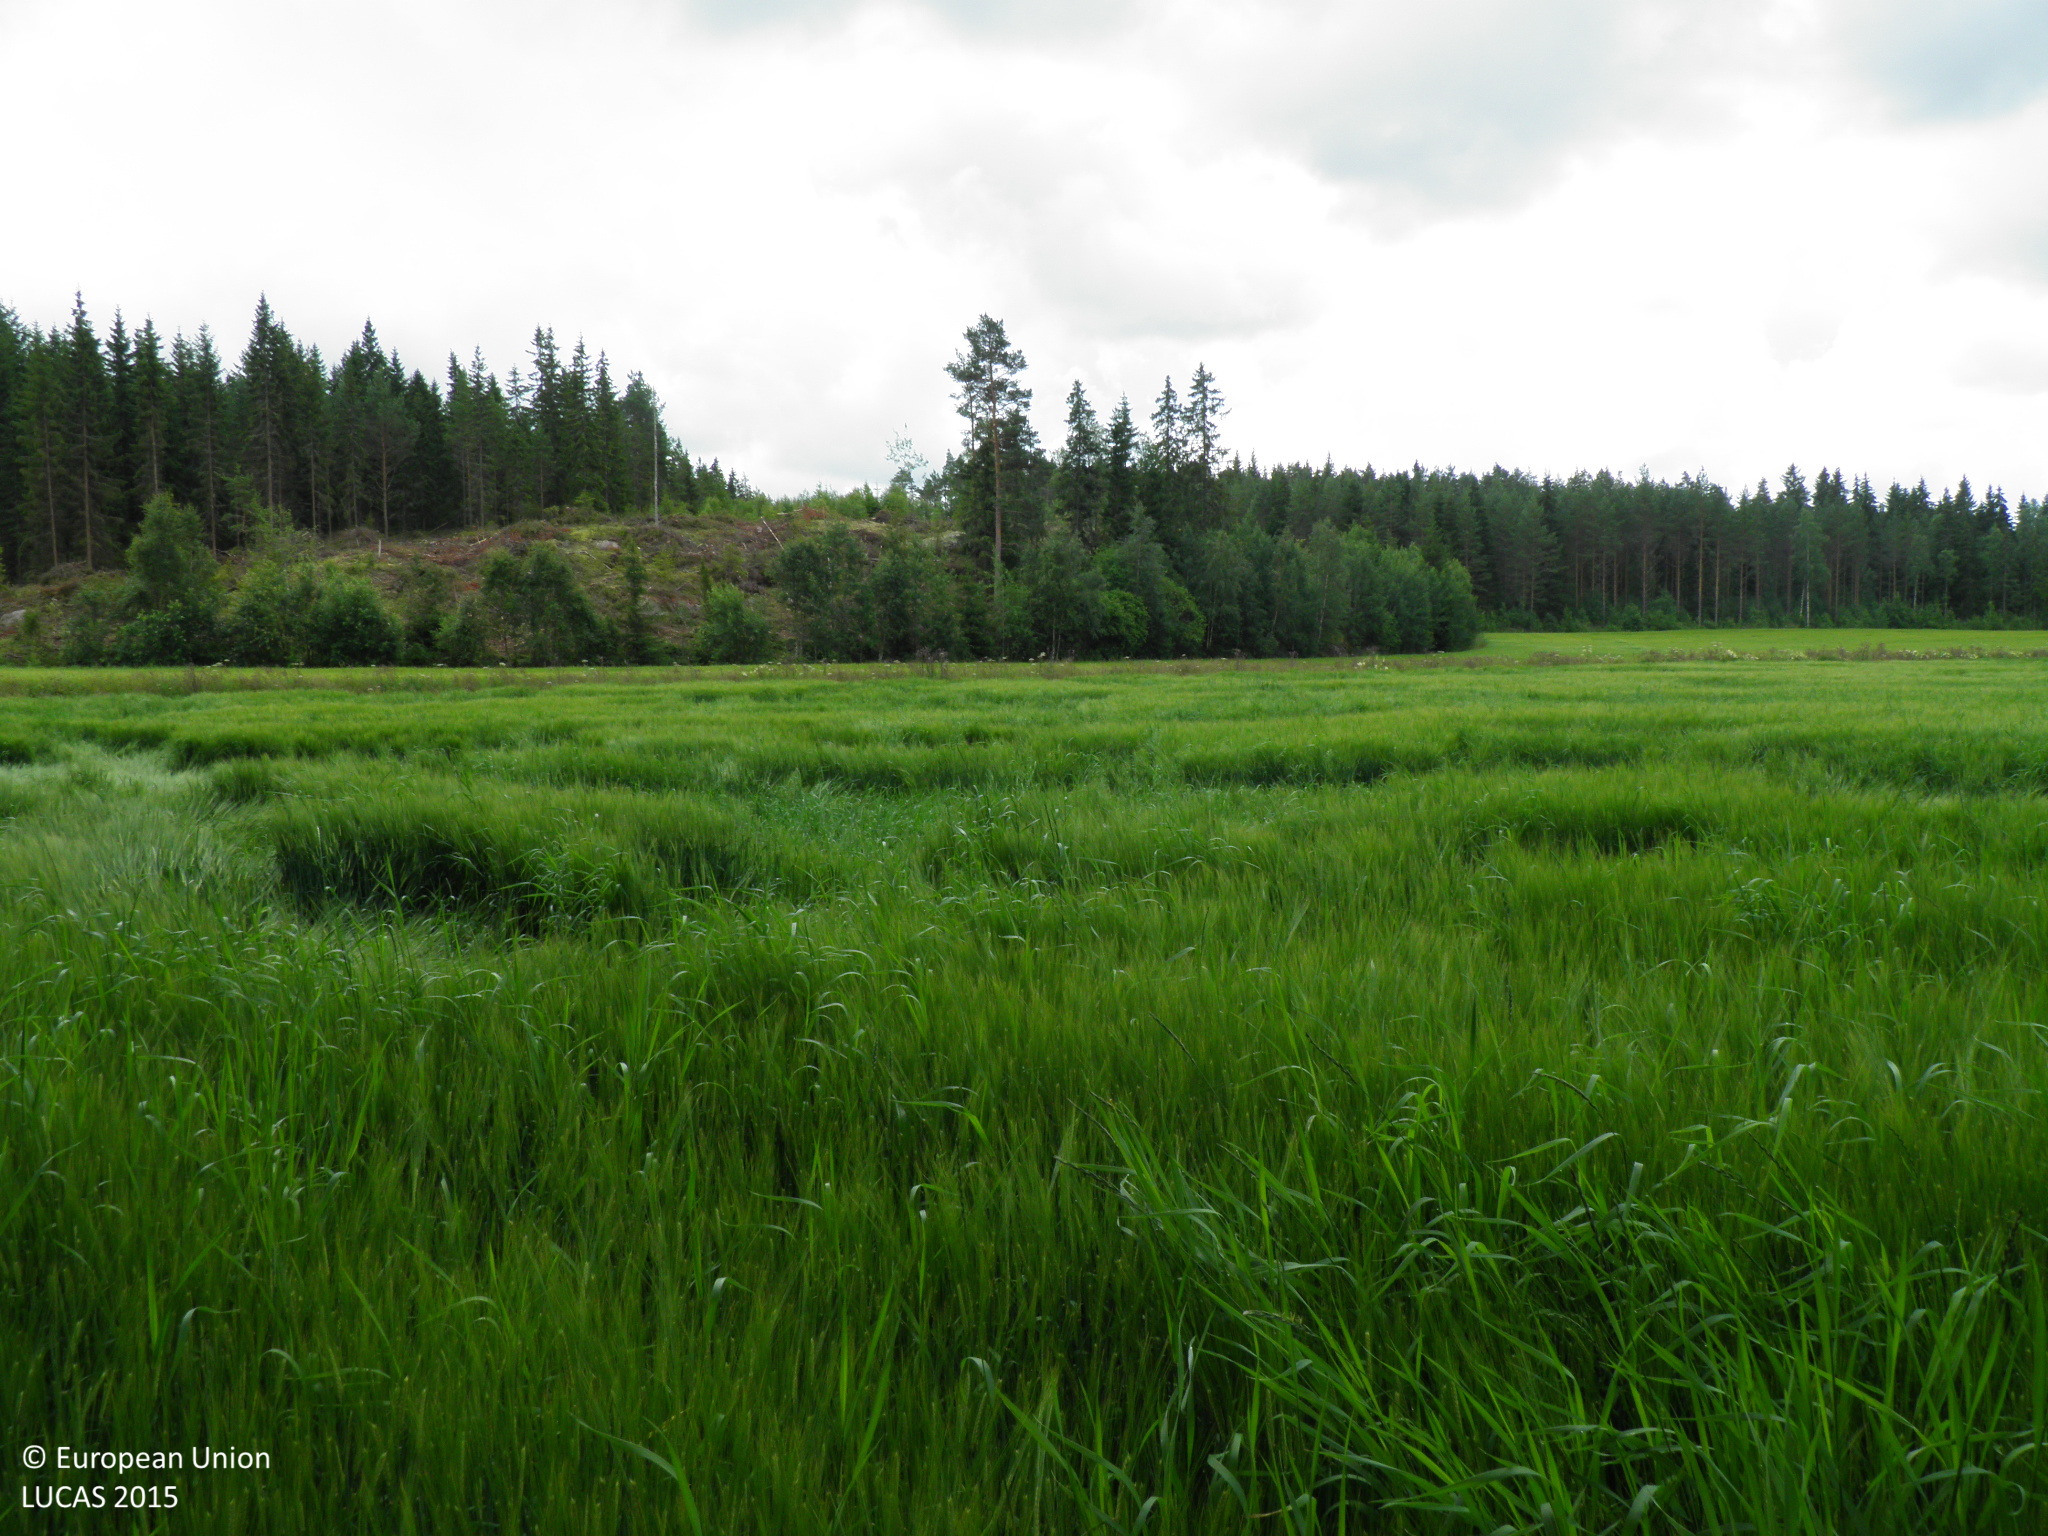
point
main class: Cropland
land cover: Barley
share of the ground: > 75 %
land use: Agriculture (excluding fallow land and kitchen gardens)
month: July
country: FI
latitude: 60.7044
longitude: 21.5803
